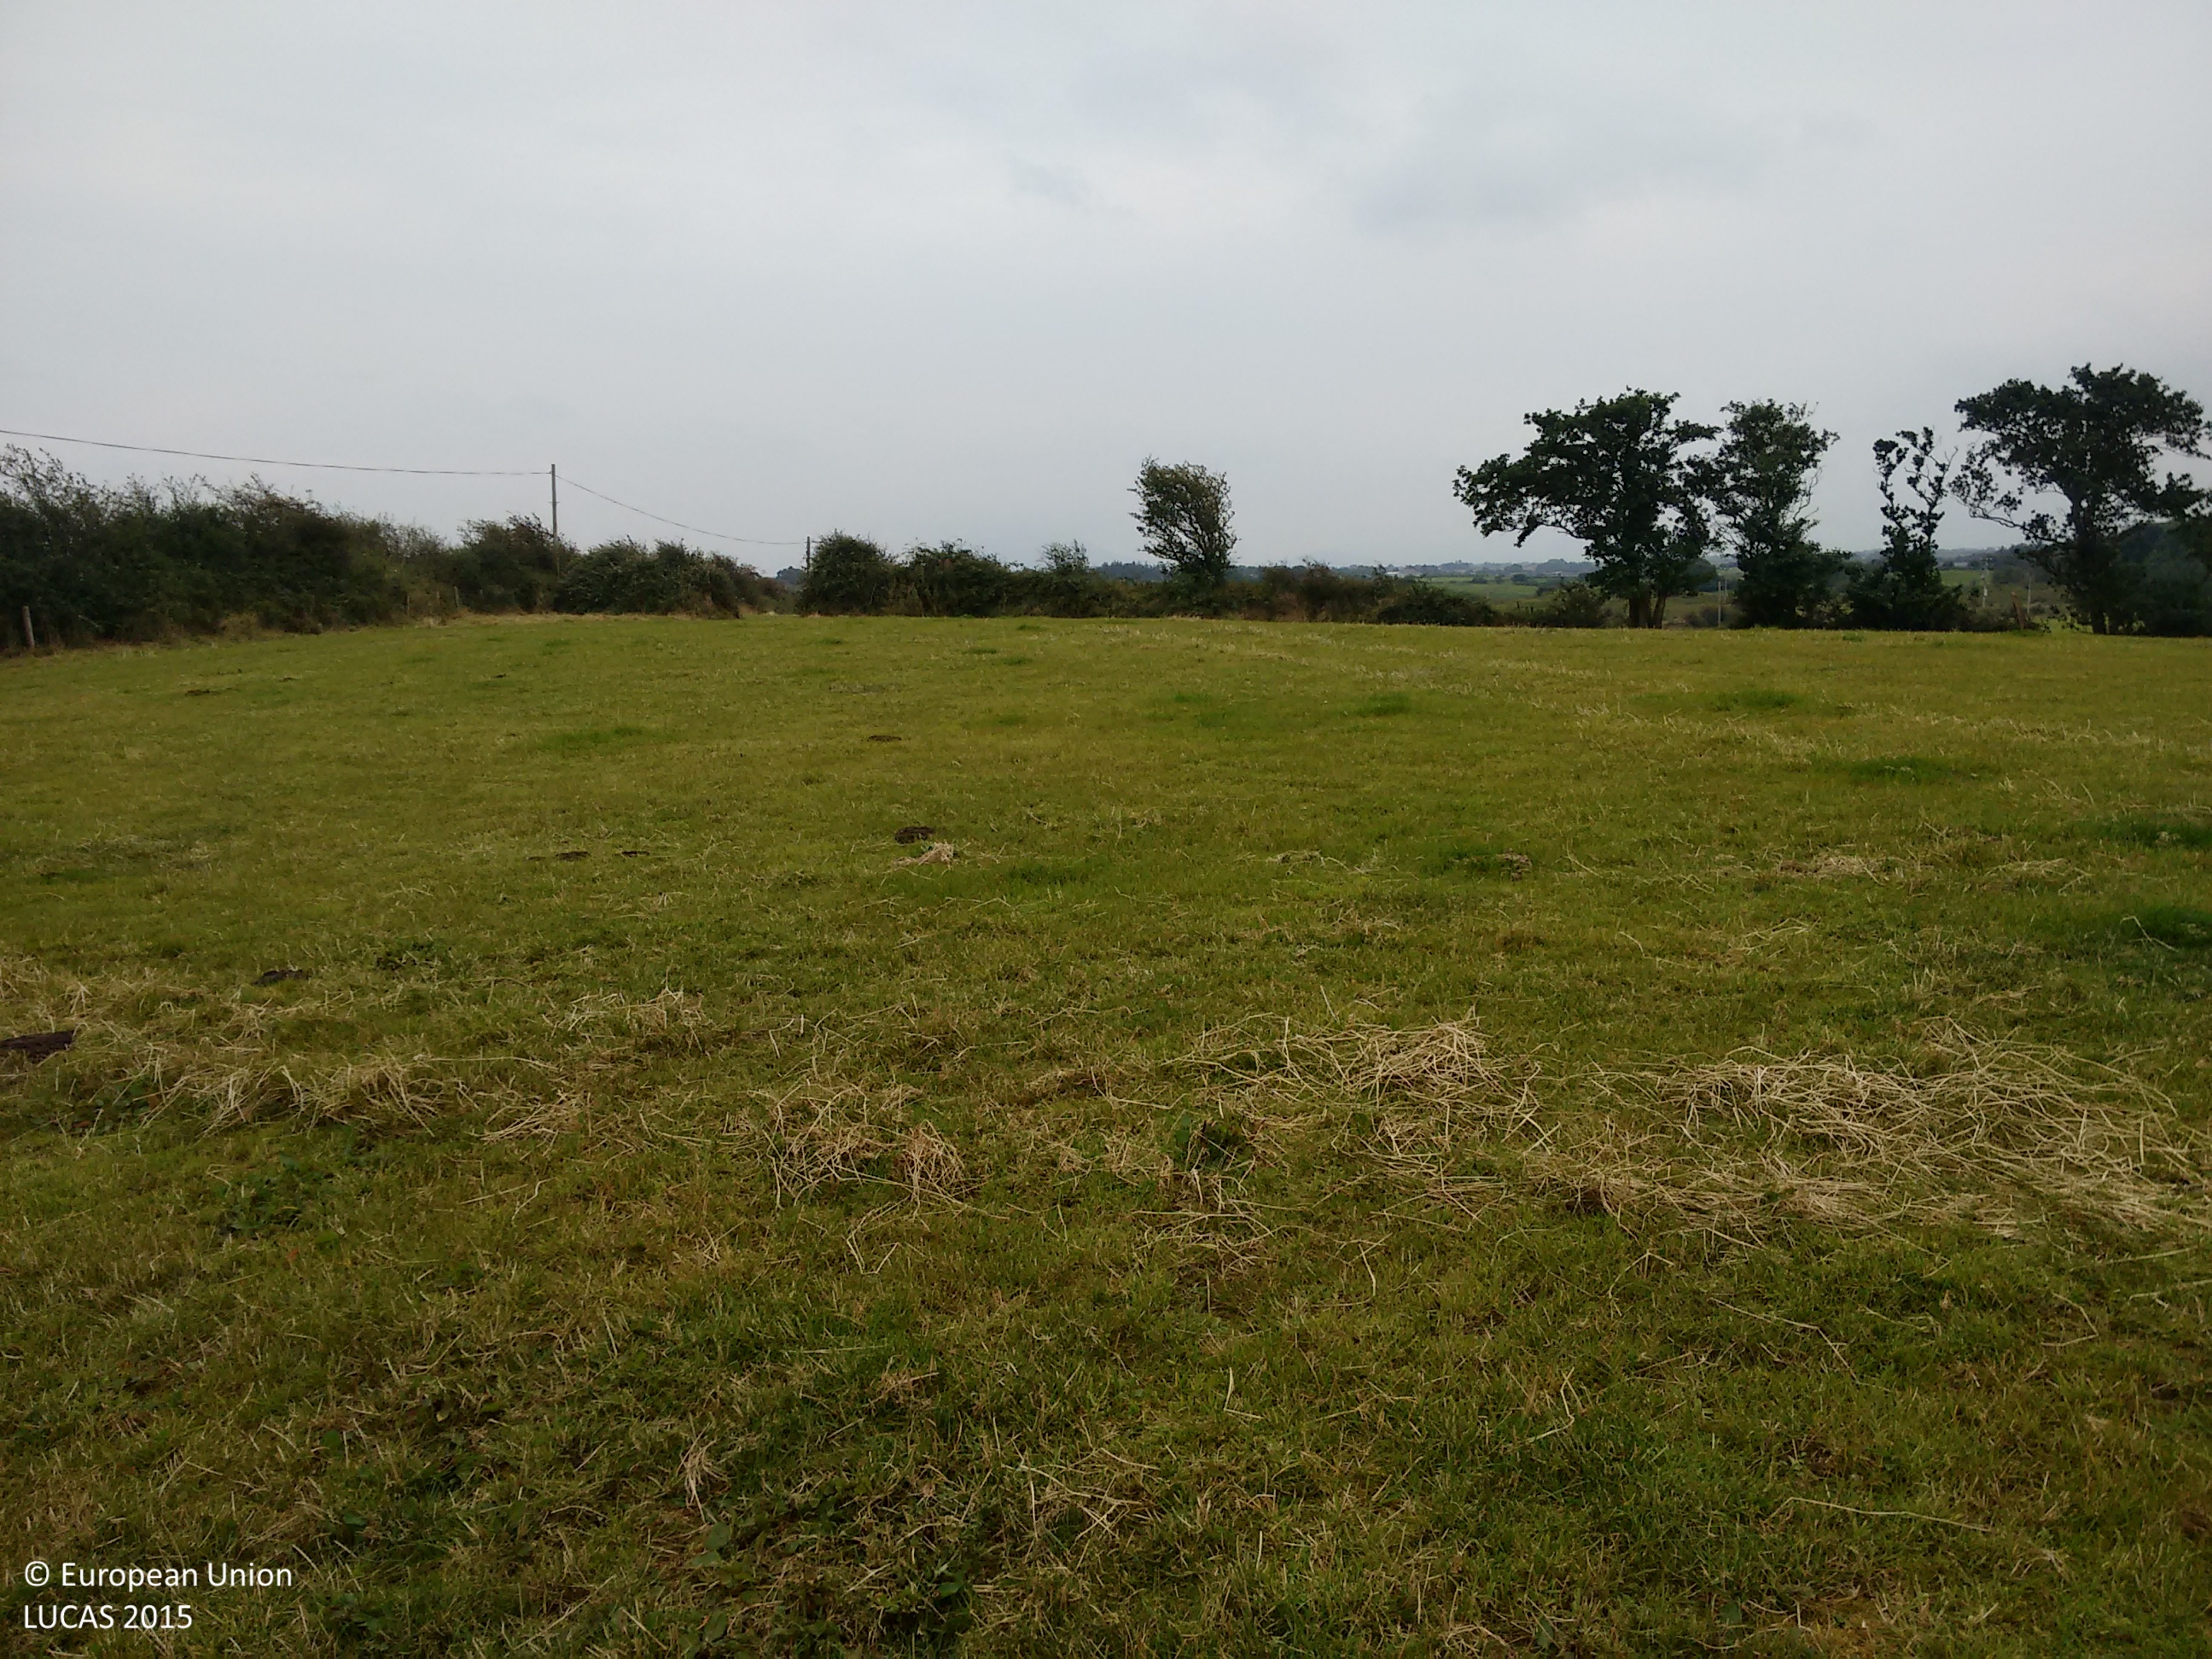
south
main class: Grassland
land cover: Grassland without tree/shrub cover
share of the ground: > 75 %
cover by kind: herbaceous plants 100 %
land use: Agriculture (excluding fallow land and kitchen gardens)
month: September
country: IE
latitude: 54.1977
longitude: -9.3073
